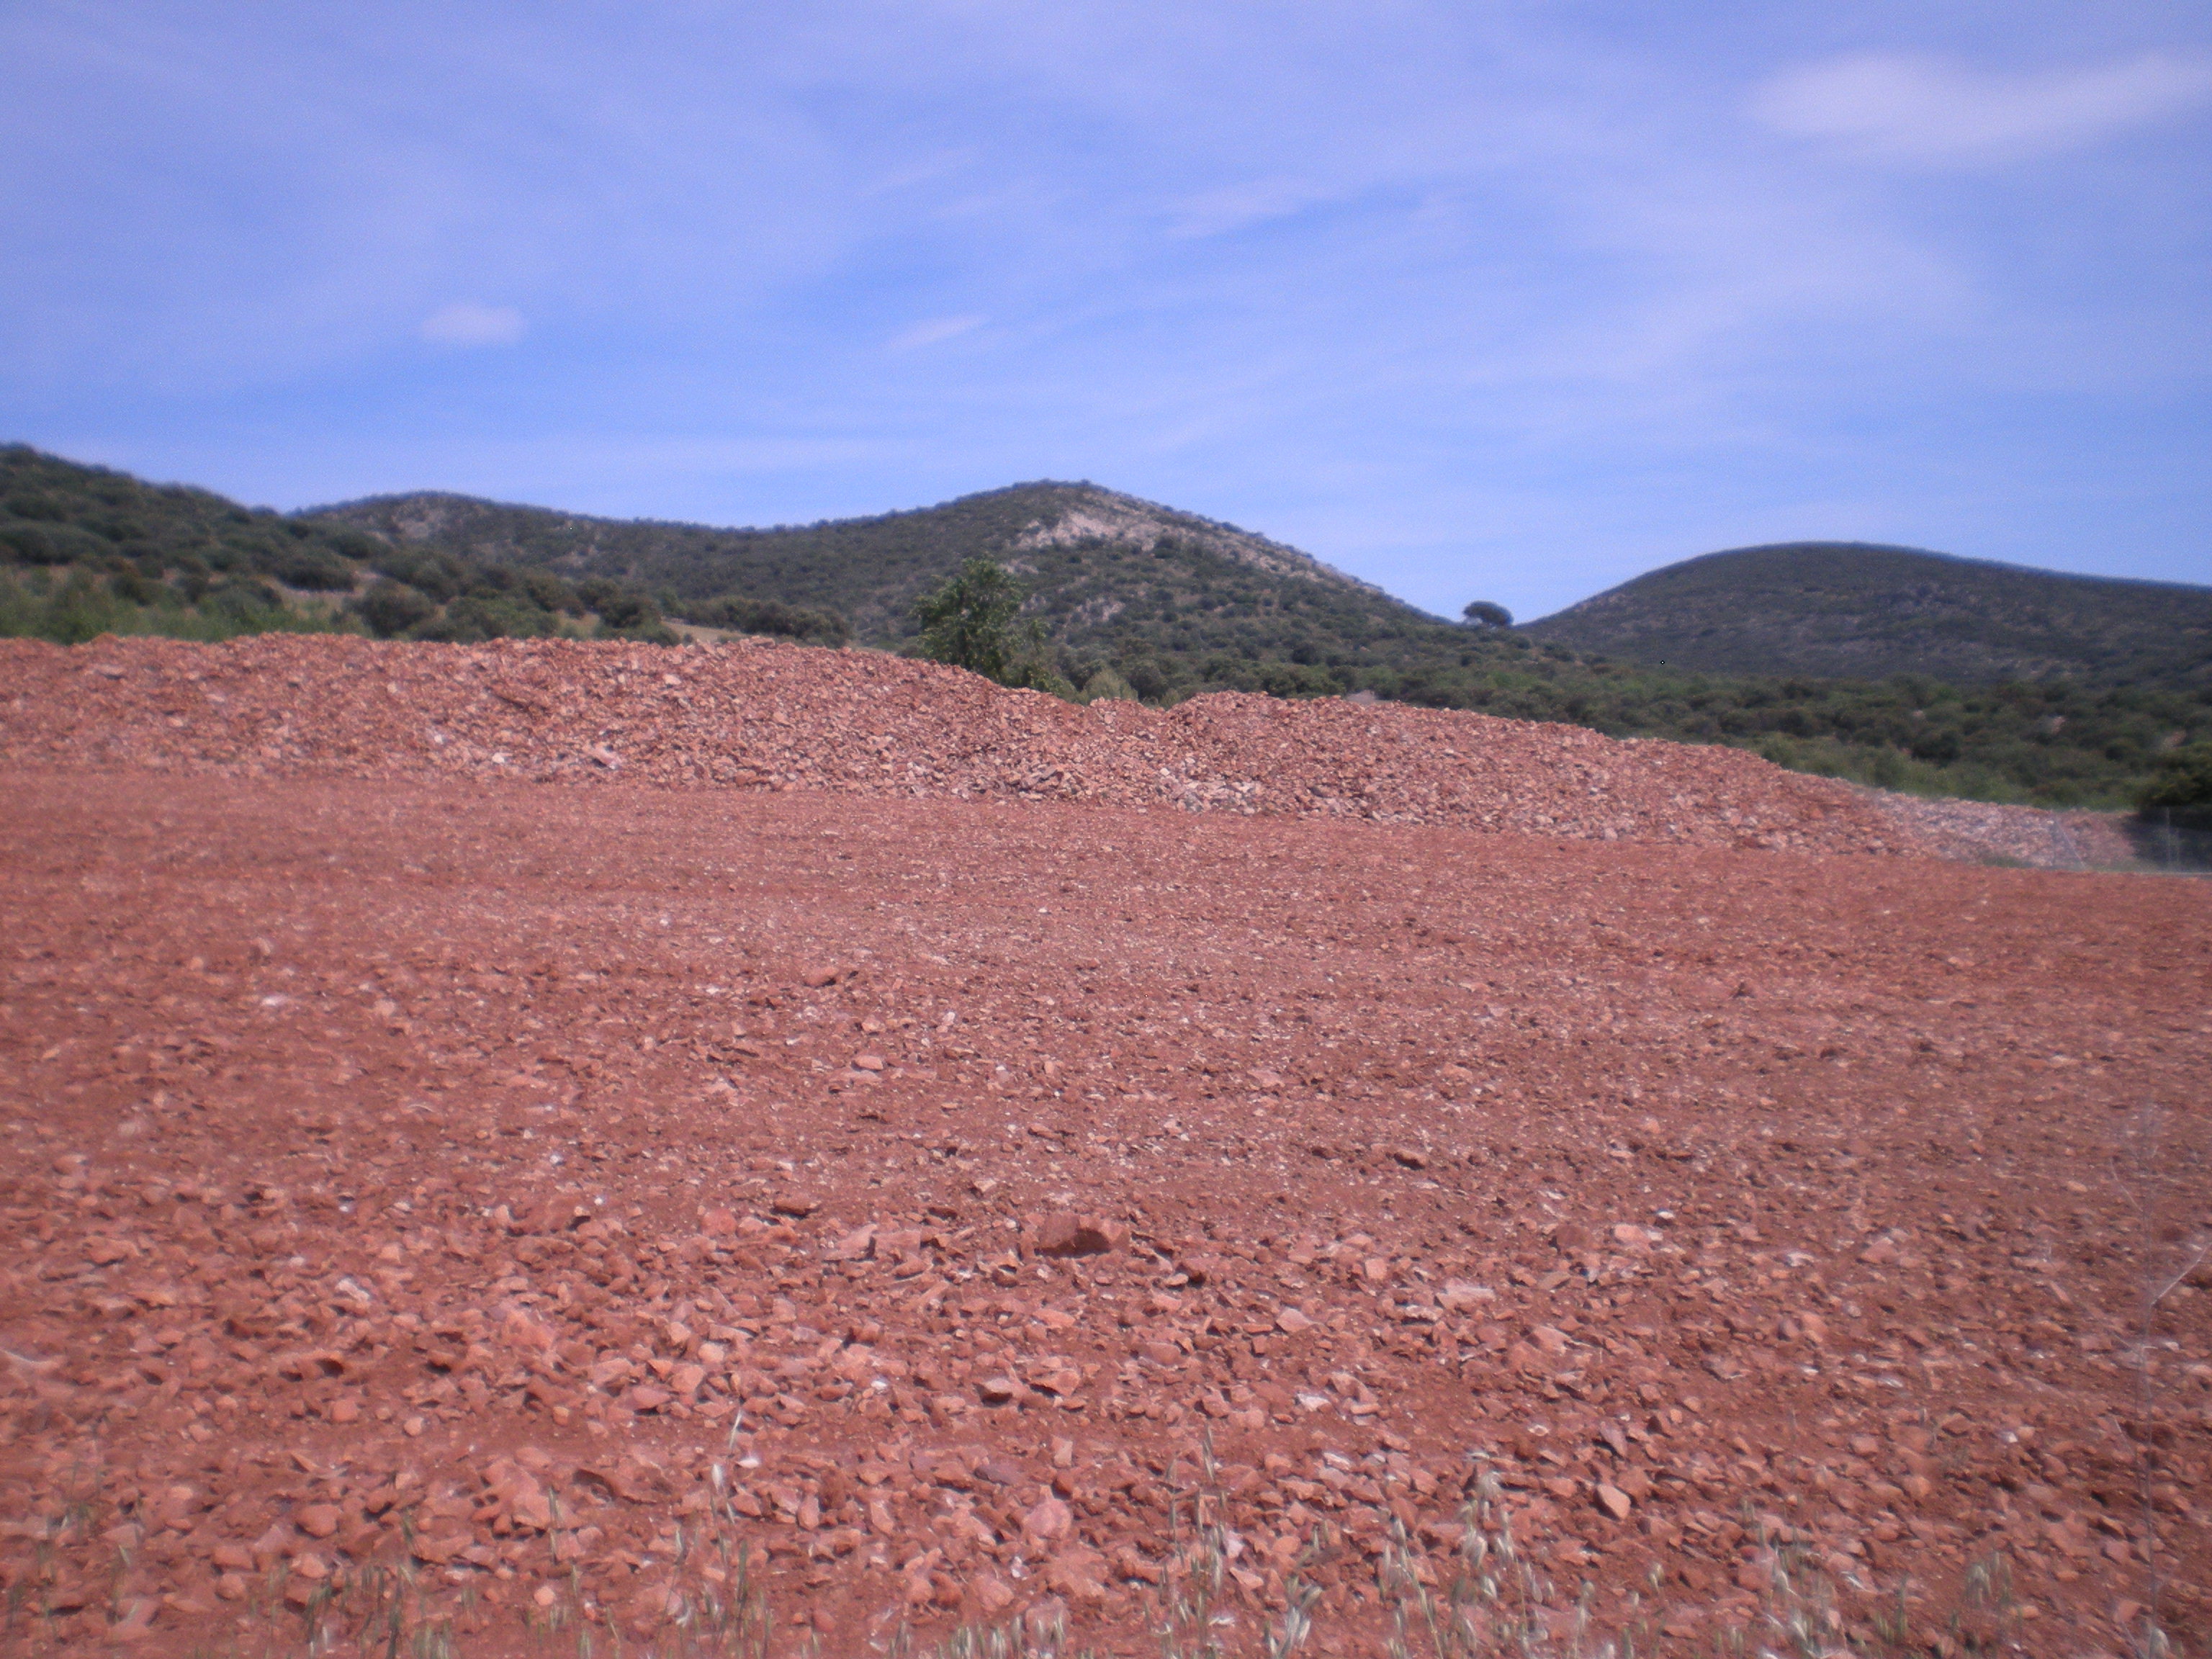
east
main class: Cropland
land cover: Olive groves
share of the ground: < 10 %
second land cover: Spontaneously vegetated surfaces
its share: 10 - 25 %
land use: Agriculture (excluding fallow land and kitchen gardens)
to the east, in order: Olive groves; Spontaneously vegetated surfaces; Fences; Dry stone walls; Other bare soil; Dry stone walls; Grass margins; Nuts trees; Dry stone walls; Nuts trees; Dry stone walls; Nuts trees
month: May
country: ES
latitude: 38.8279
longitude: -3.5484
